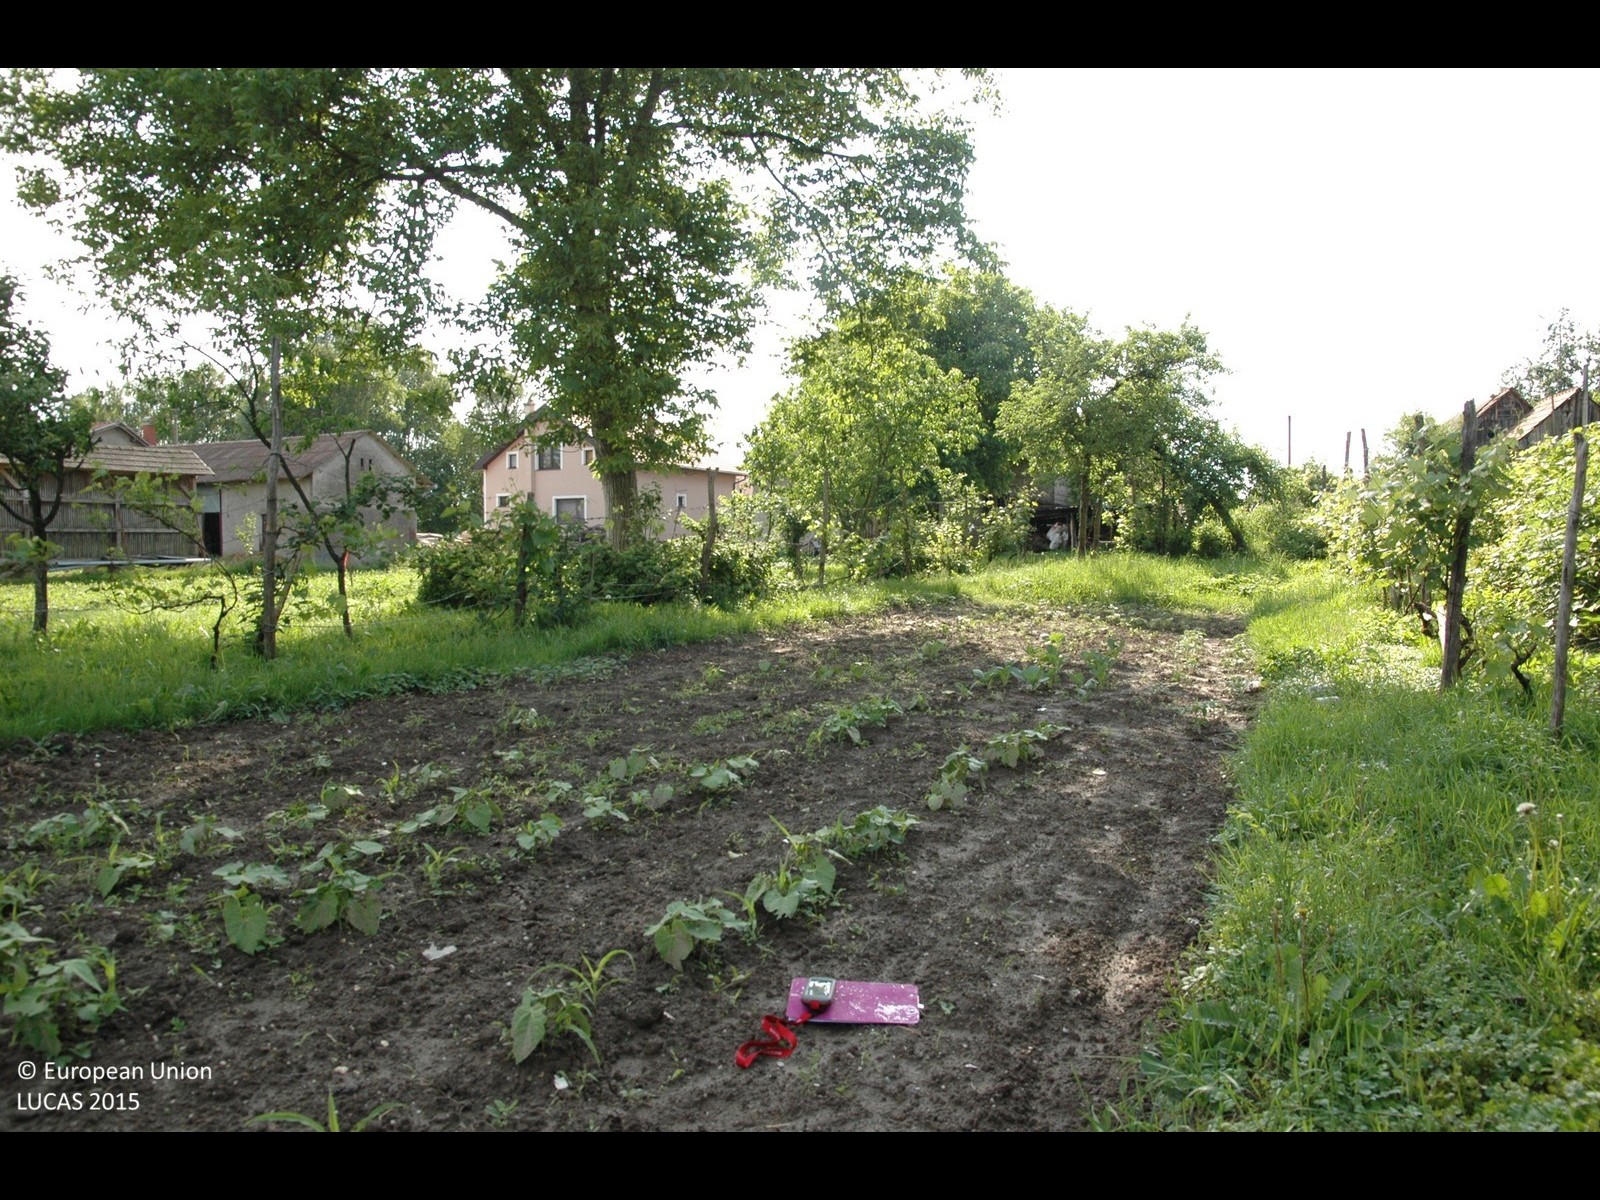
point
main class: Cropland
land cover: Dry pulses
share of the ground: > 75 %
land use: Kitchen garden
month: May
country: HR
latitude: 46.3142
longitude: 16.8194
